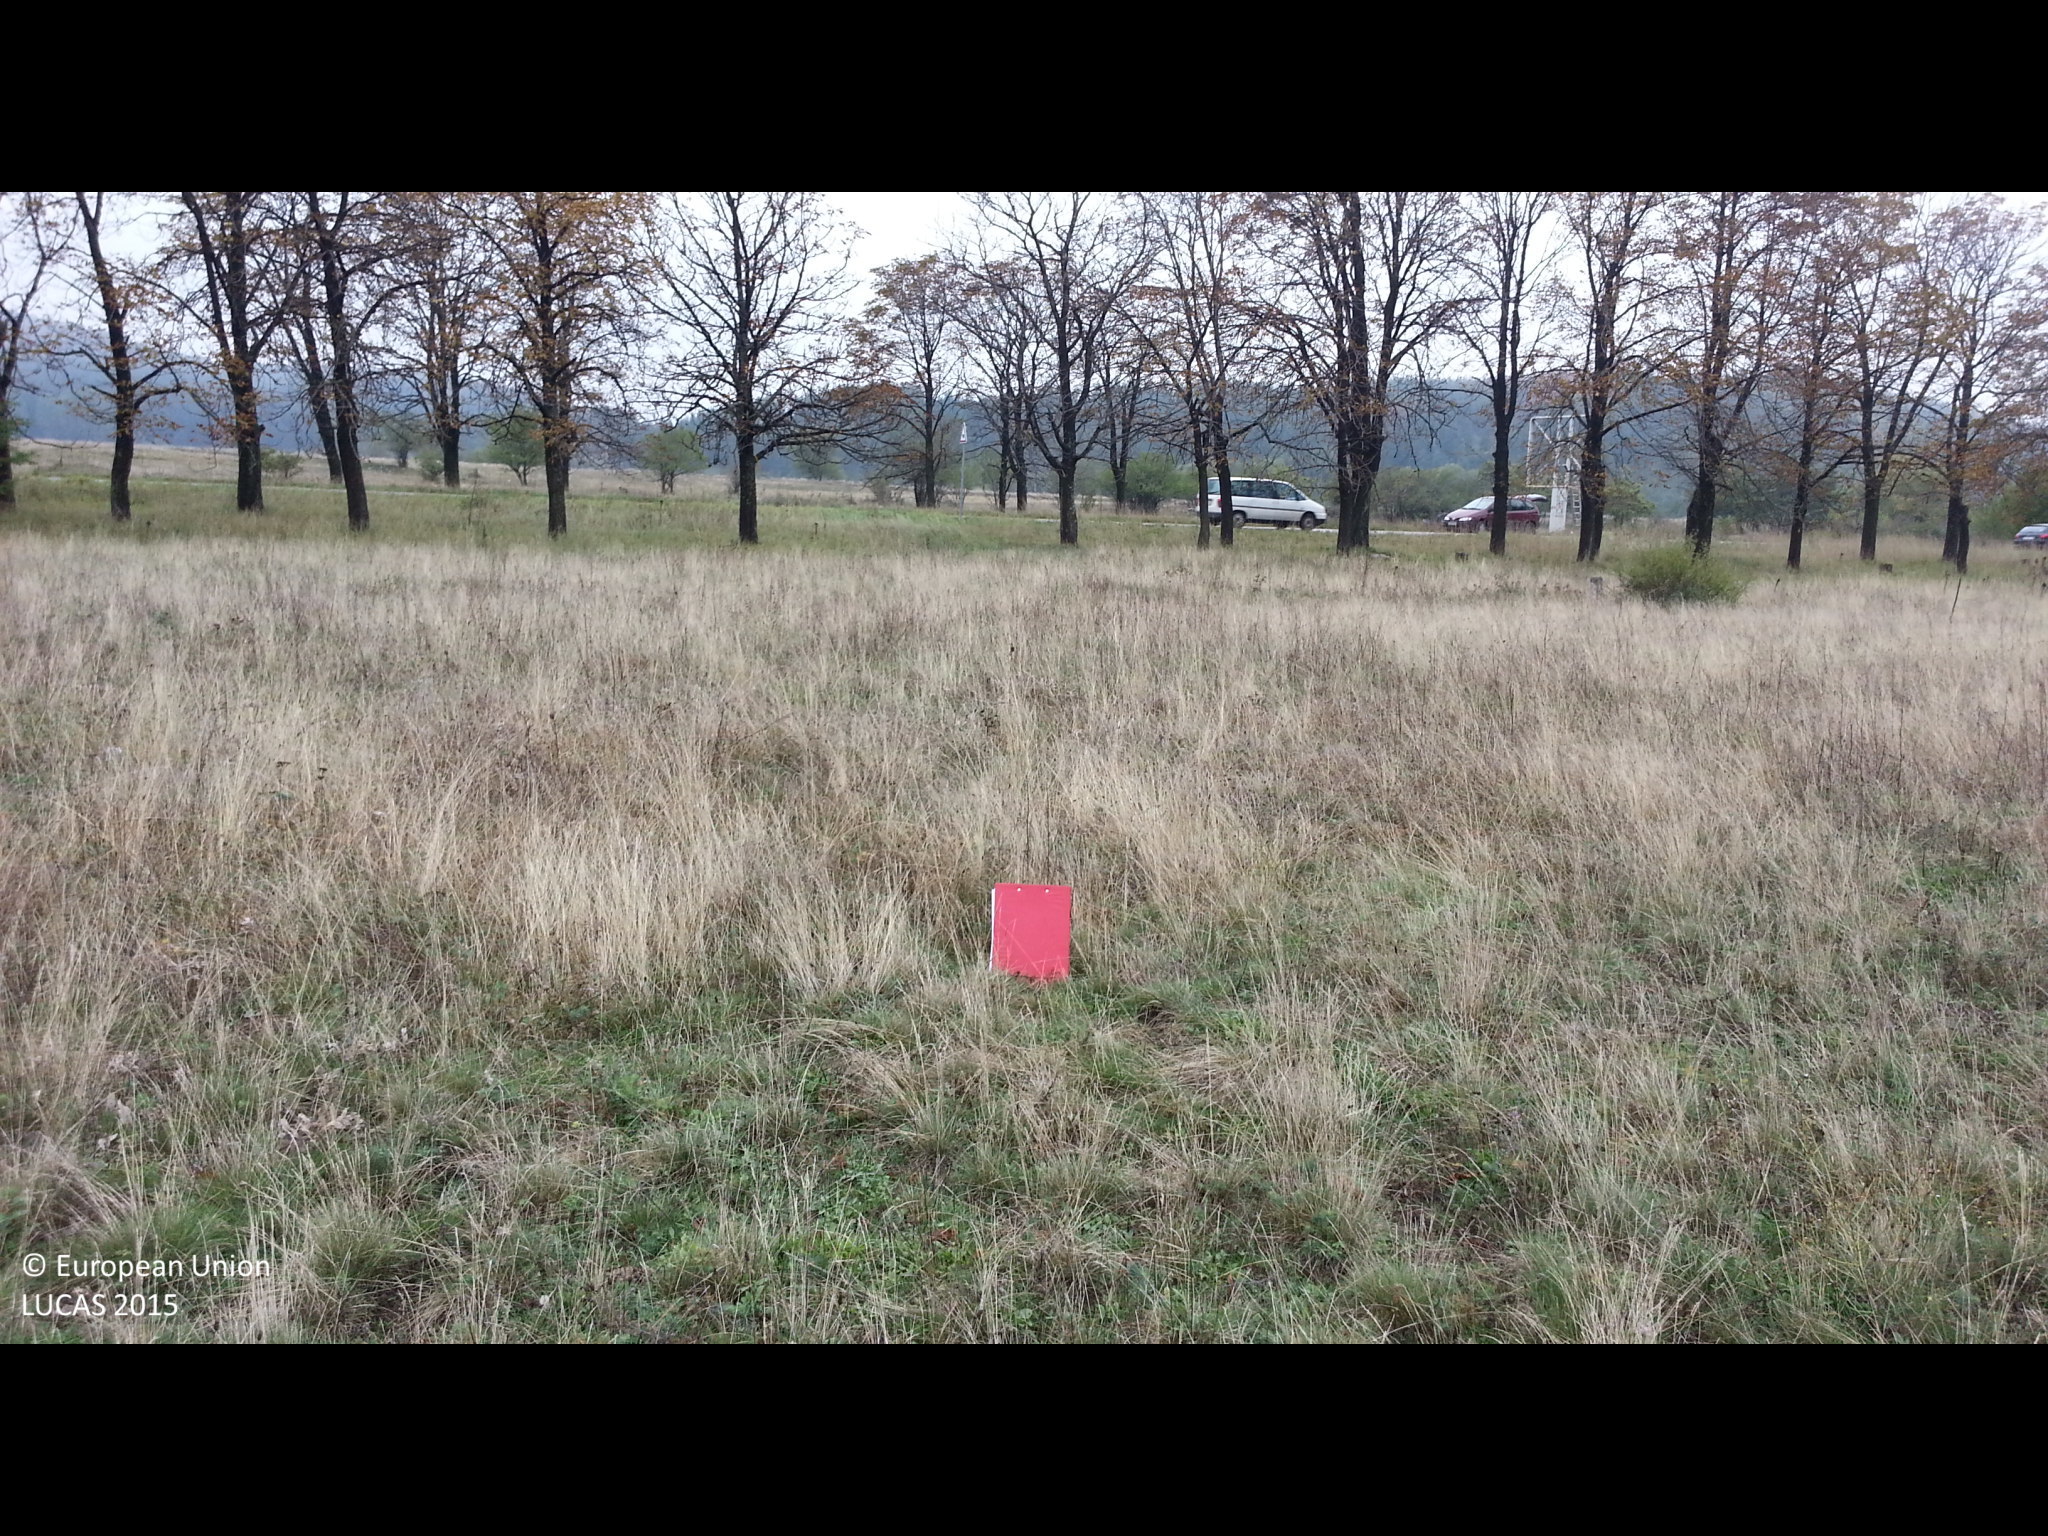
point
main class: Grassland
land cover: Grassland without tree/shrub cover
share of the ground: > 75 %
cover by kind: herbaceous plants 100 %
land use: Agriculture (excluding fallow land and kitchen gardens)
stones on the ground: < 10 %
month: October
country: BG
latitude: 42.3608
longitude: 23.5478
